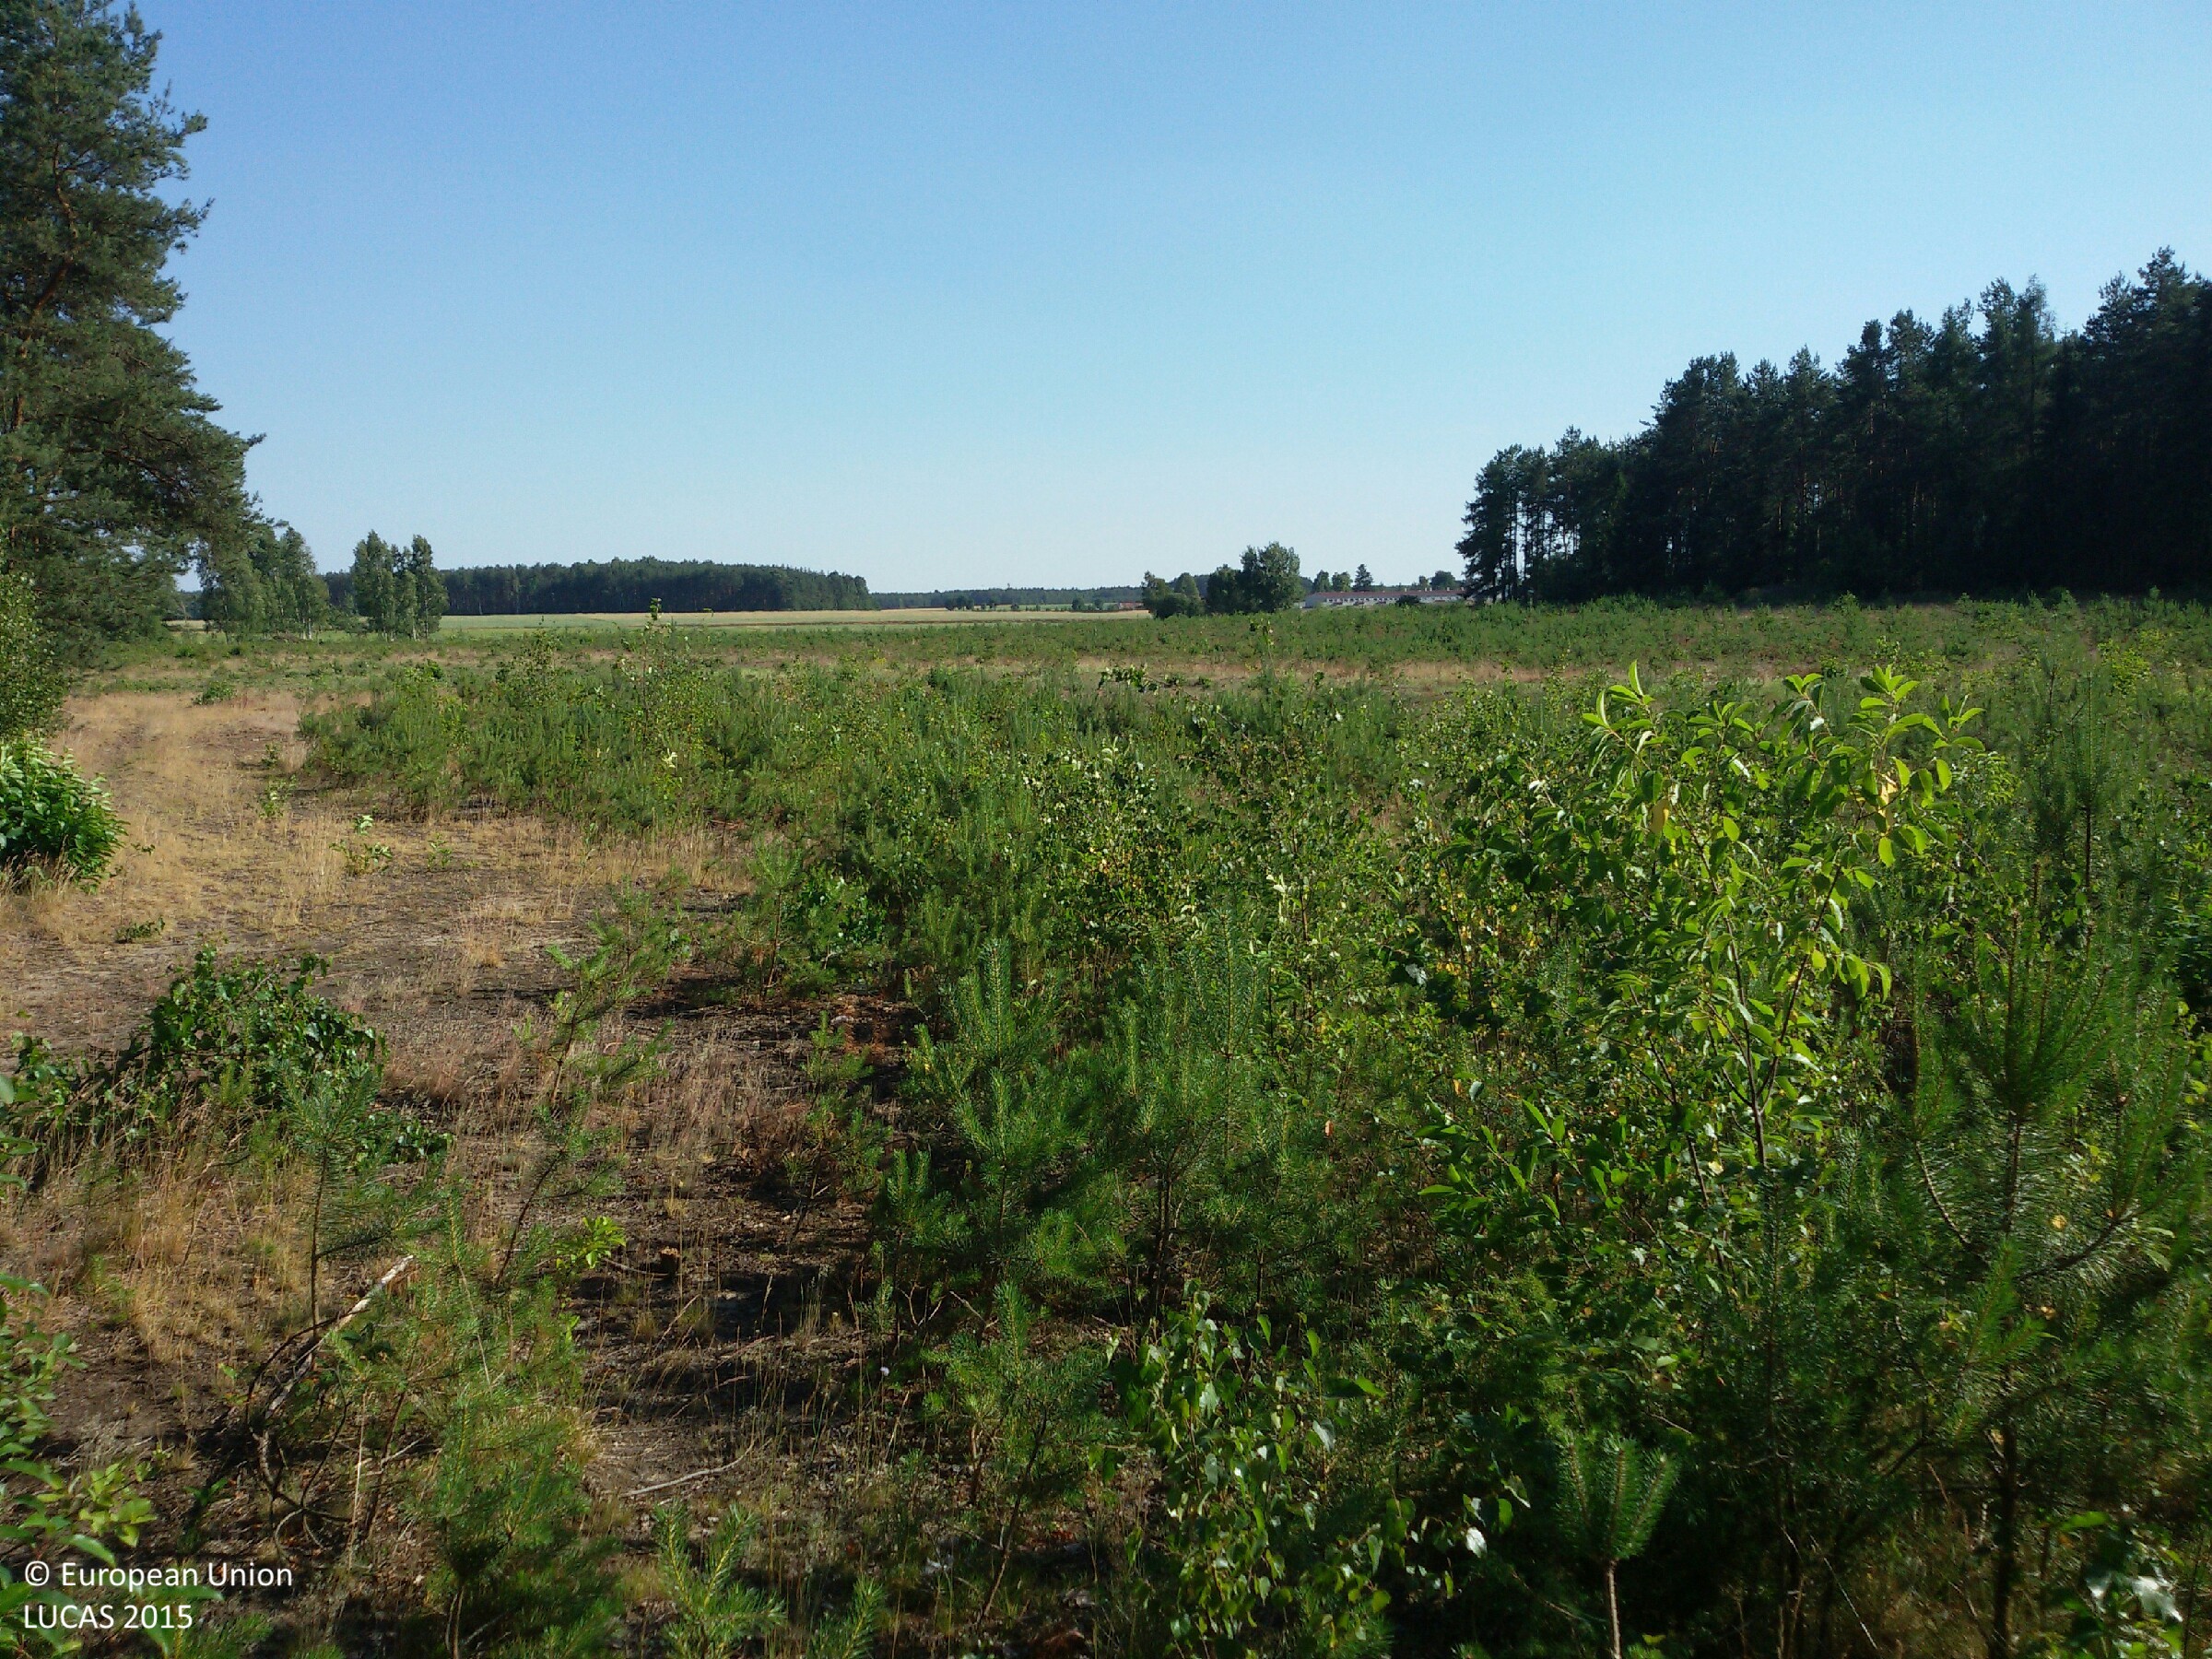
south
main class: Woodland
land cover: Pine dominated mixed woodland
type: hemiboreal forest and nemoral coniferous forest and mixed broadleaved-coniferous forest
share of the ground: 10 - 25 %
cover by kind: herbaceous plants 55 %, coniferous forest trees 10 %, broadleaved forest trees 10 %, lichens and mosses 10 %, unconsolidated bare surface 10 %, shrubs 5 %
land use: Forestry
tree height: < 5 m
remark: Nursery
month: July
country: PL
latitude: 53.1727
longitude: 20.1620
